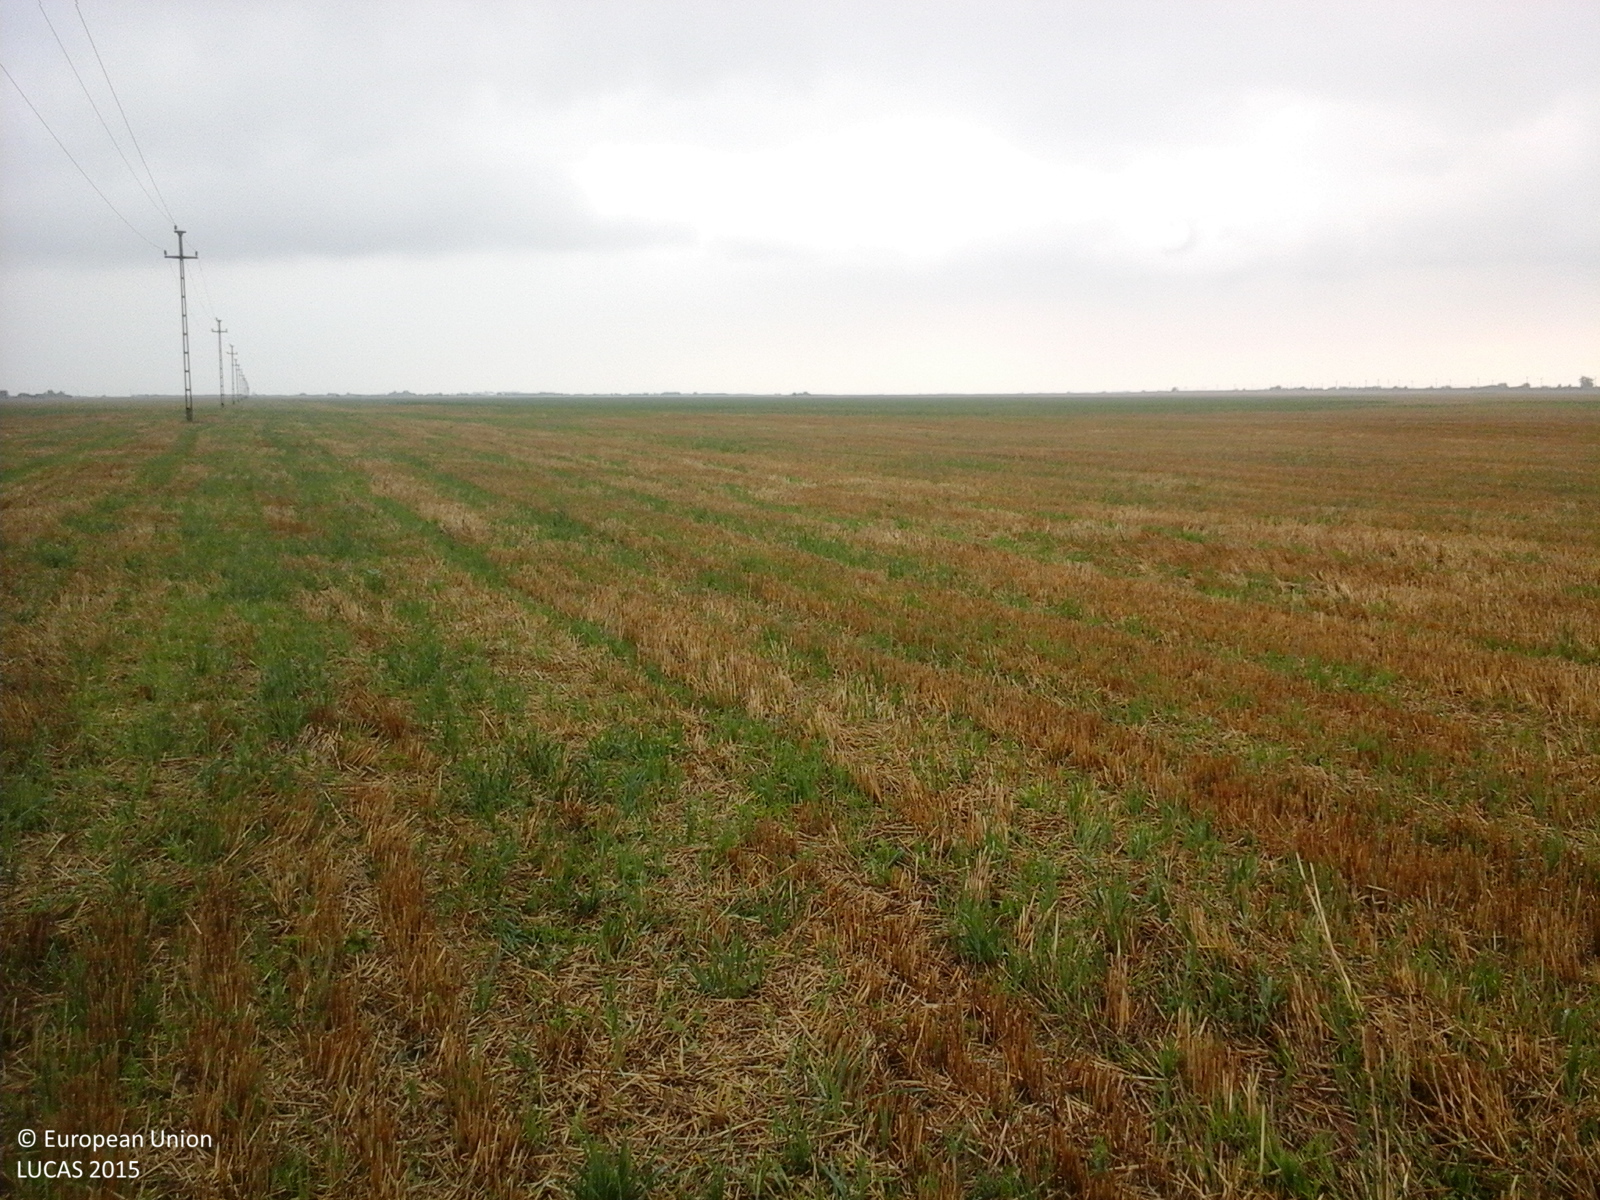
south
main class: Cropland
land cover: Durum wheat
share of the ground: < 10 %
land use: Agriculture (excluding fallow land and kitchen gardens)
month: August
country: RO
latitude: 46.1775
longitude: 20.5047
